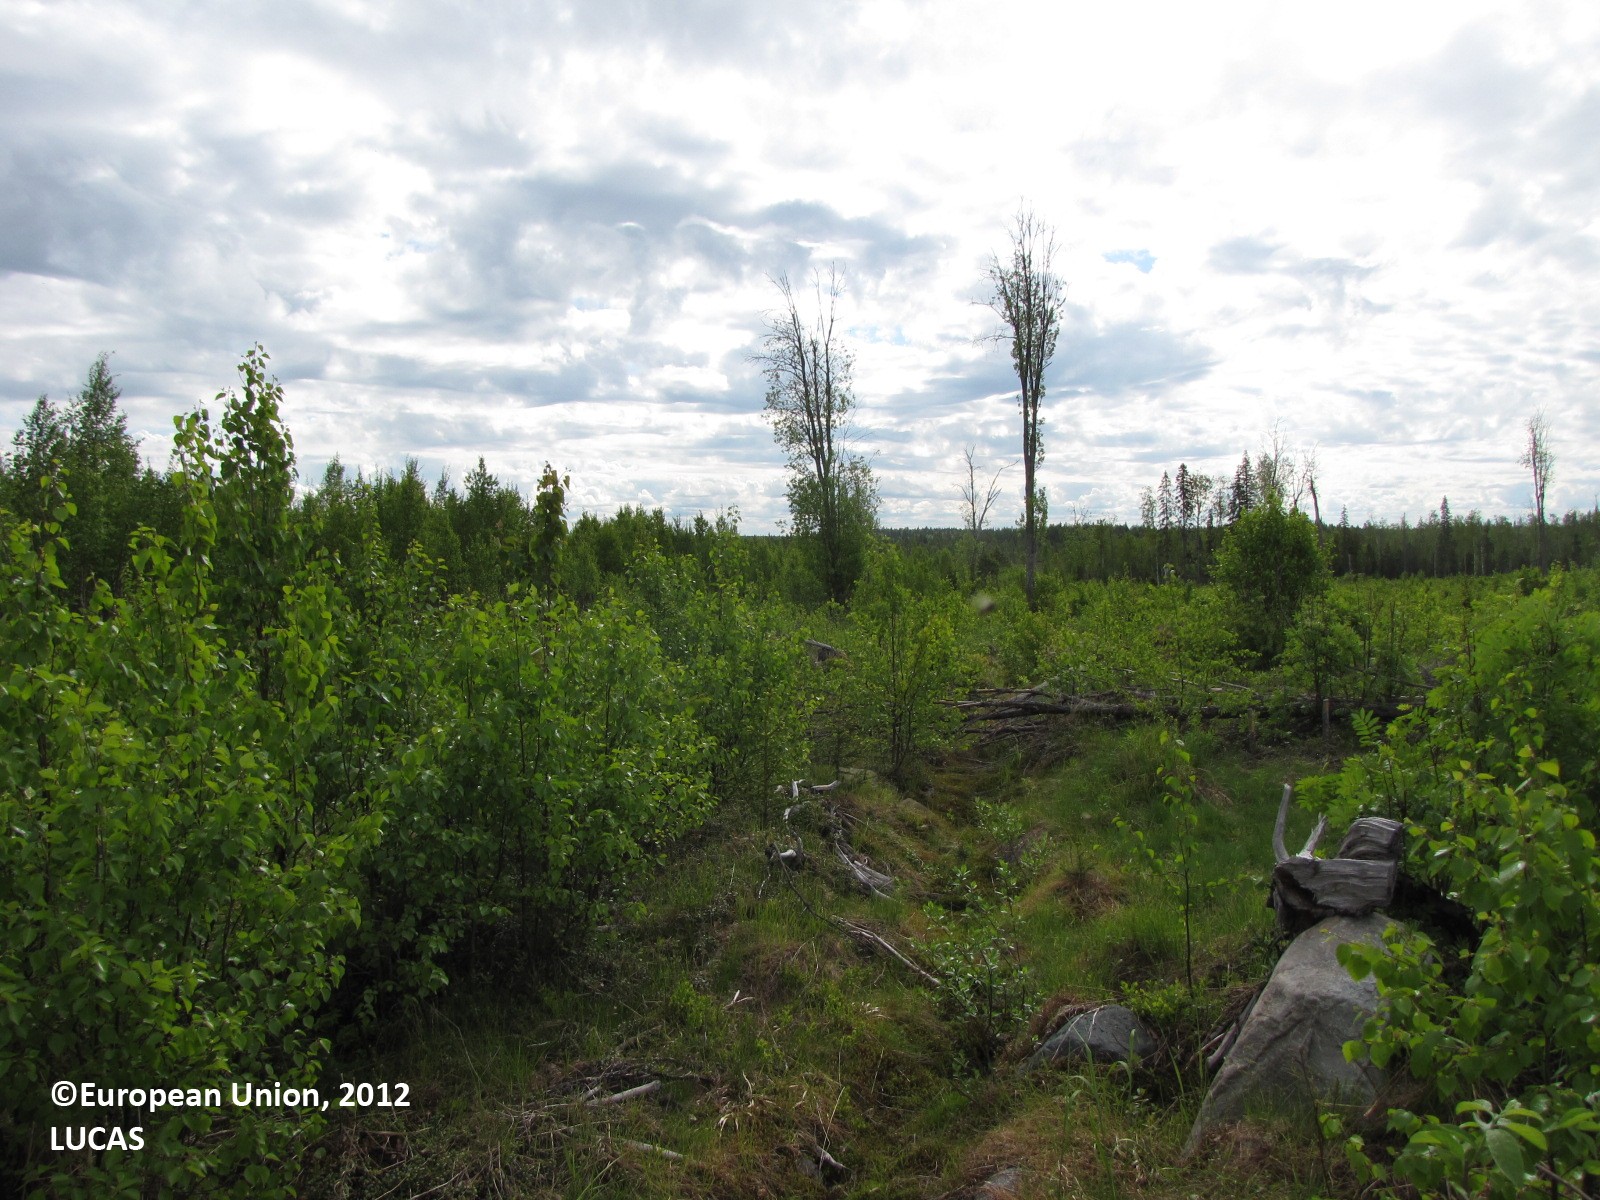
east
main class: Woodland
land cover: Broadleaved woodland
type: boreal forest
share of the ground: 25 - 50 %
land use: Forestry
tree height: < 5 m
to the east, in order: Broadleaved woodland; Ditches and canals; Broadleaved woodland; Other mixed woodland; Ditches and canals; Other mixed woodland
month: June
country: FI
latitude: 66.0574
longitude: 24.6499
